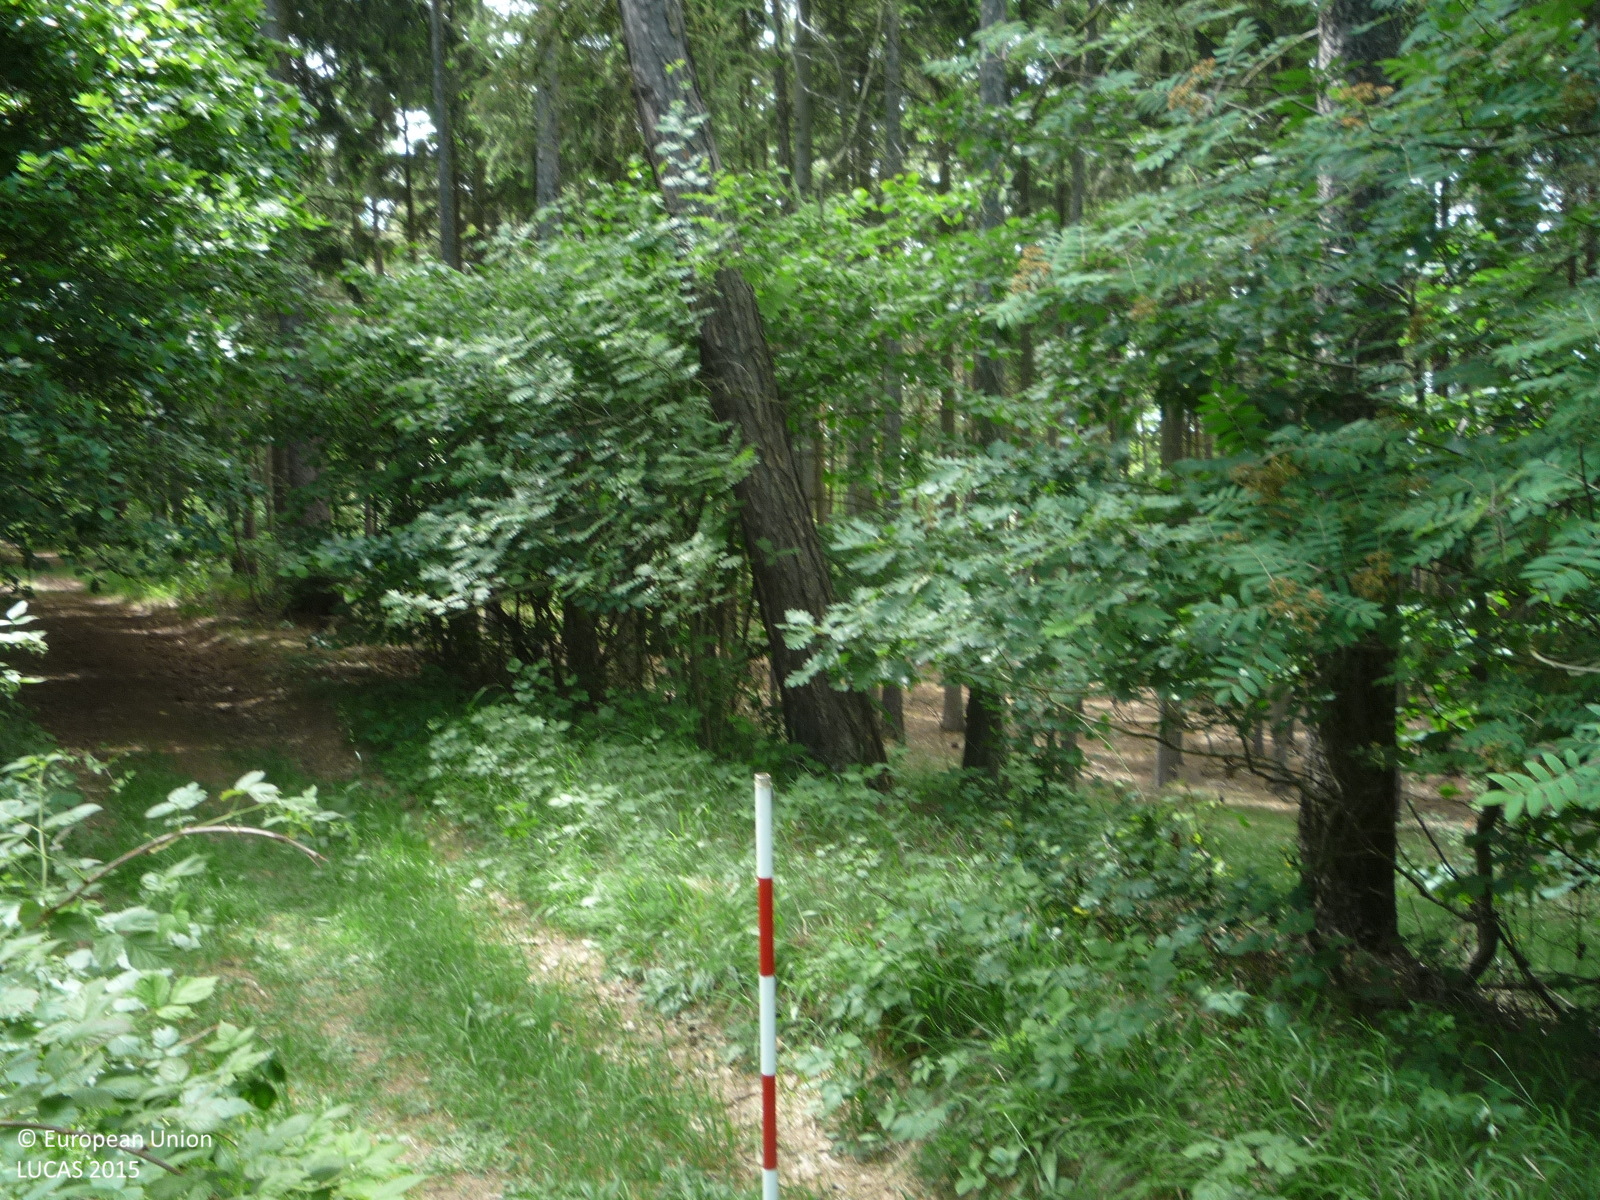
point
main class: Woodland
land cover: Spruce dominated coniferous woodland
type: hemiboreal forest and nemoral coniferous forest and mixed broadleaved-coniferous forest
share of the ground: > 75 %
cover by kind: coniferous forest trees 85 %, broadleaved forest trees 5 %, shrubs 5 %, herbaceous plants 5 %
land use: Forestry
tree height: > 5 m
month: June
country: CZ
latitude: 50.2999
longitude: 13.8333
